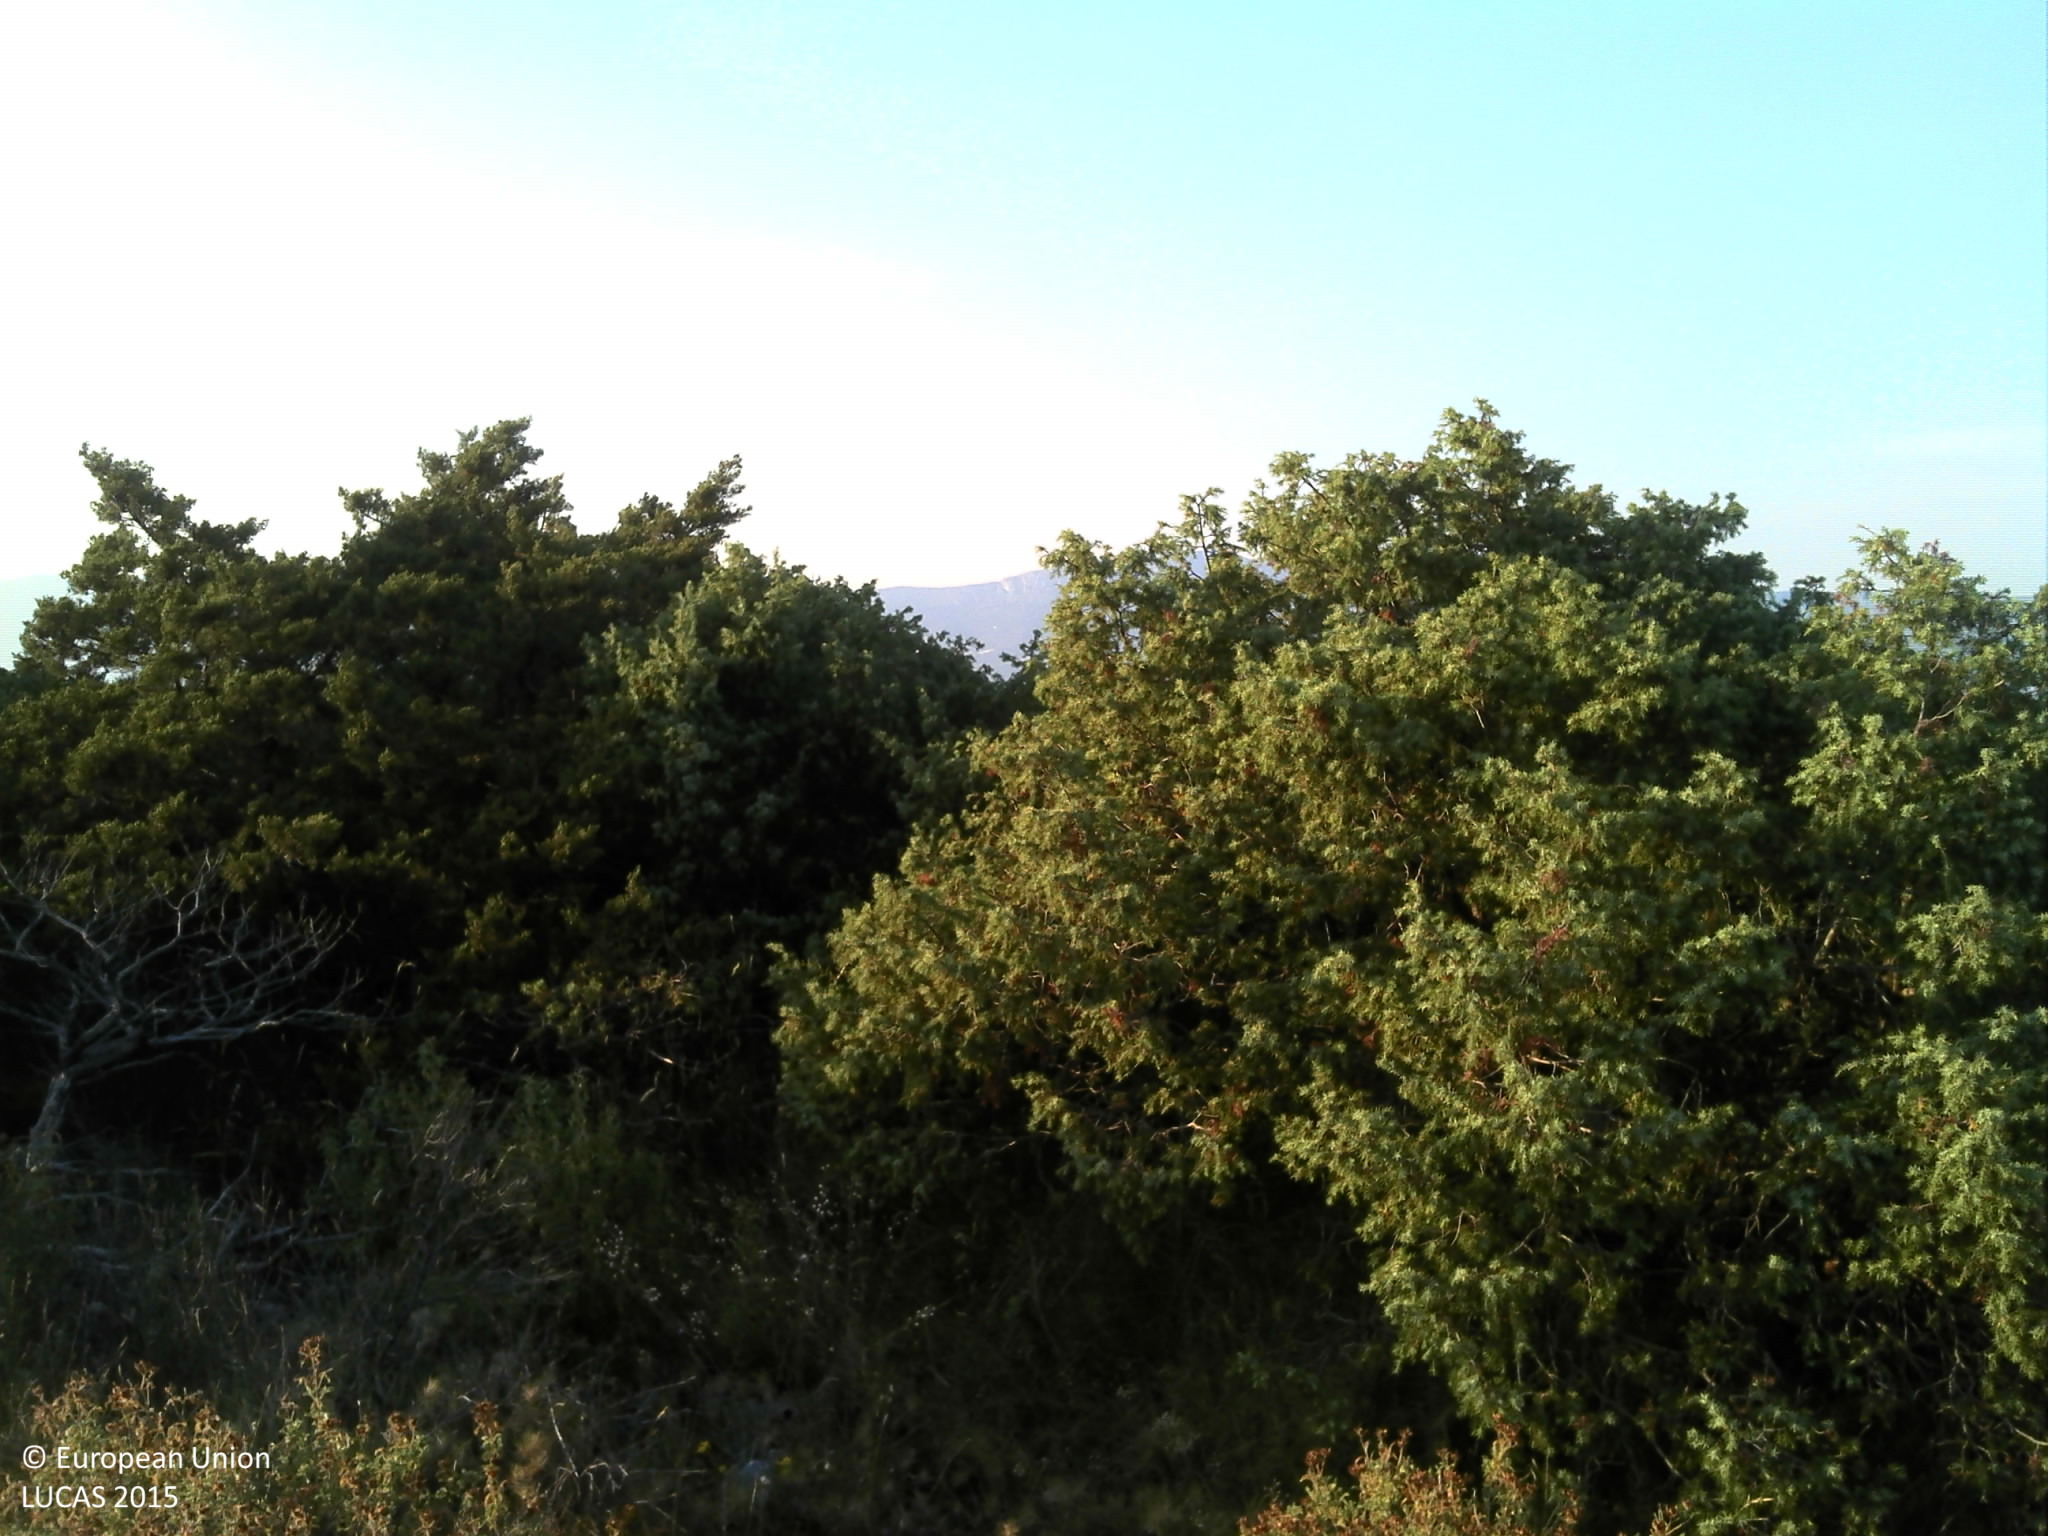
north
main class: Shrubland
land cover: Shrubland without tree cover
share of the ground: 50 - 75 %
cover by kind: shrubs 70 %, herbaceous plants 20 %, consolidated bare surface 5 %, unconsolidated bare surface 5 %
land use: Semi-natural and natural areas not in use
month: July
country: HR
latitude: 43.4861
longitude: 16.3584
